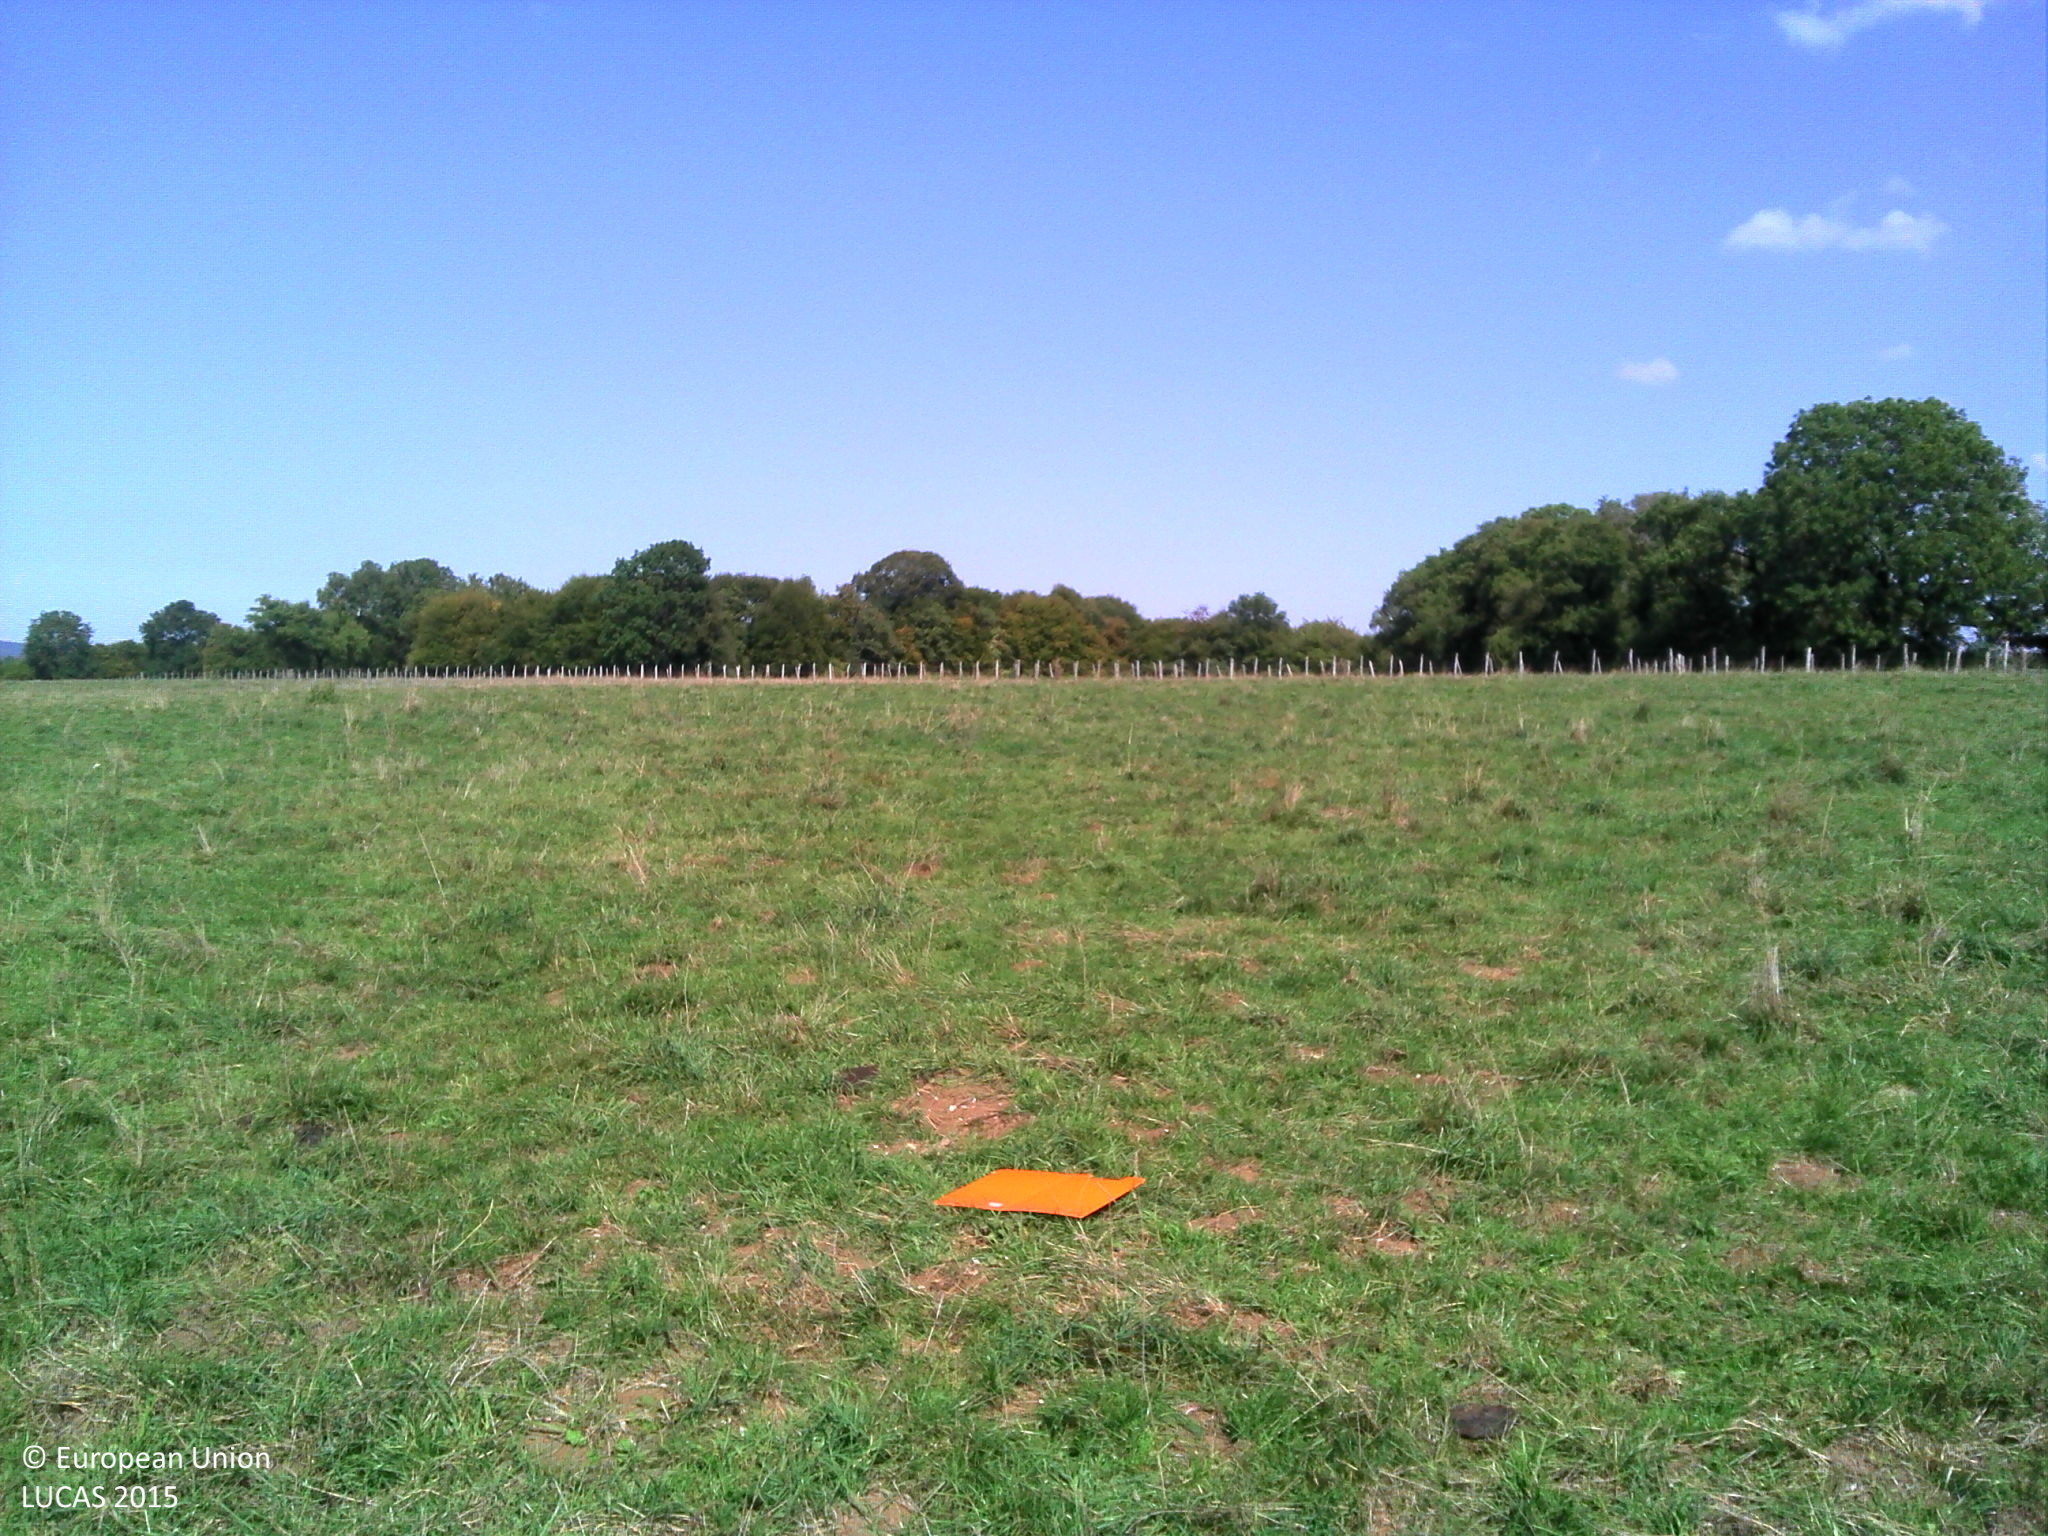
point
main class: Grassland
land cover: Grassland without tree/shrub cover
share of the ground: > 75 %
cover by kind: herbaceous plants 100 %
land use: Agriculture (excluding fallow land and kitchen gardens)
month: September
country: FR
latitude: 47.2225
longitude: 6.2382
